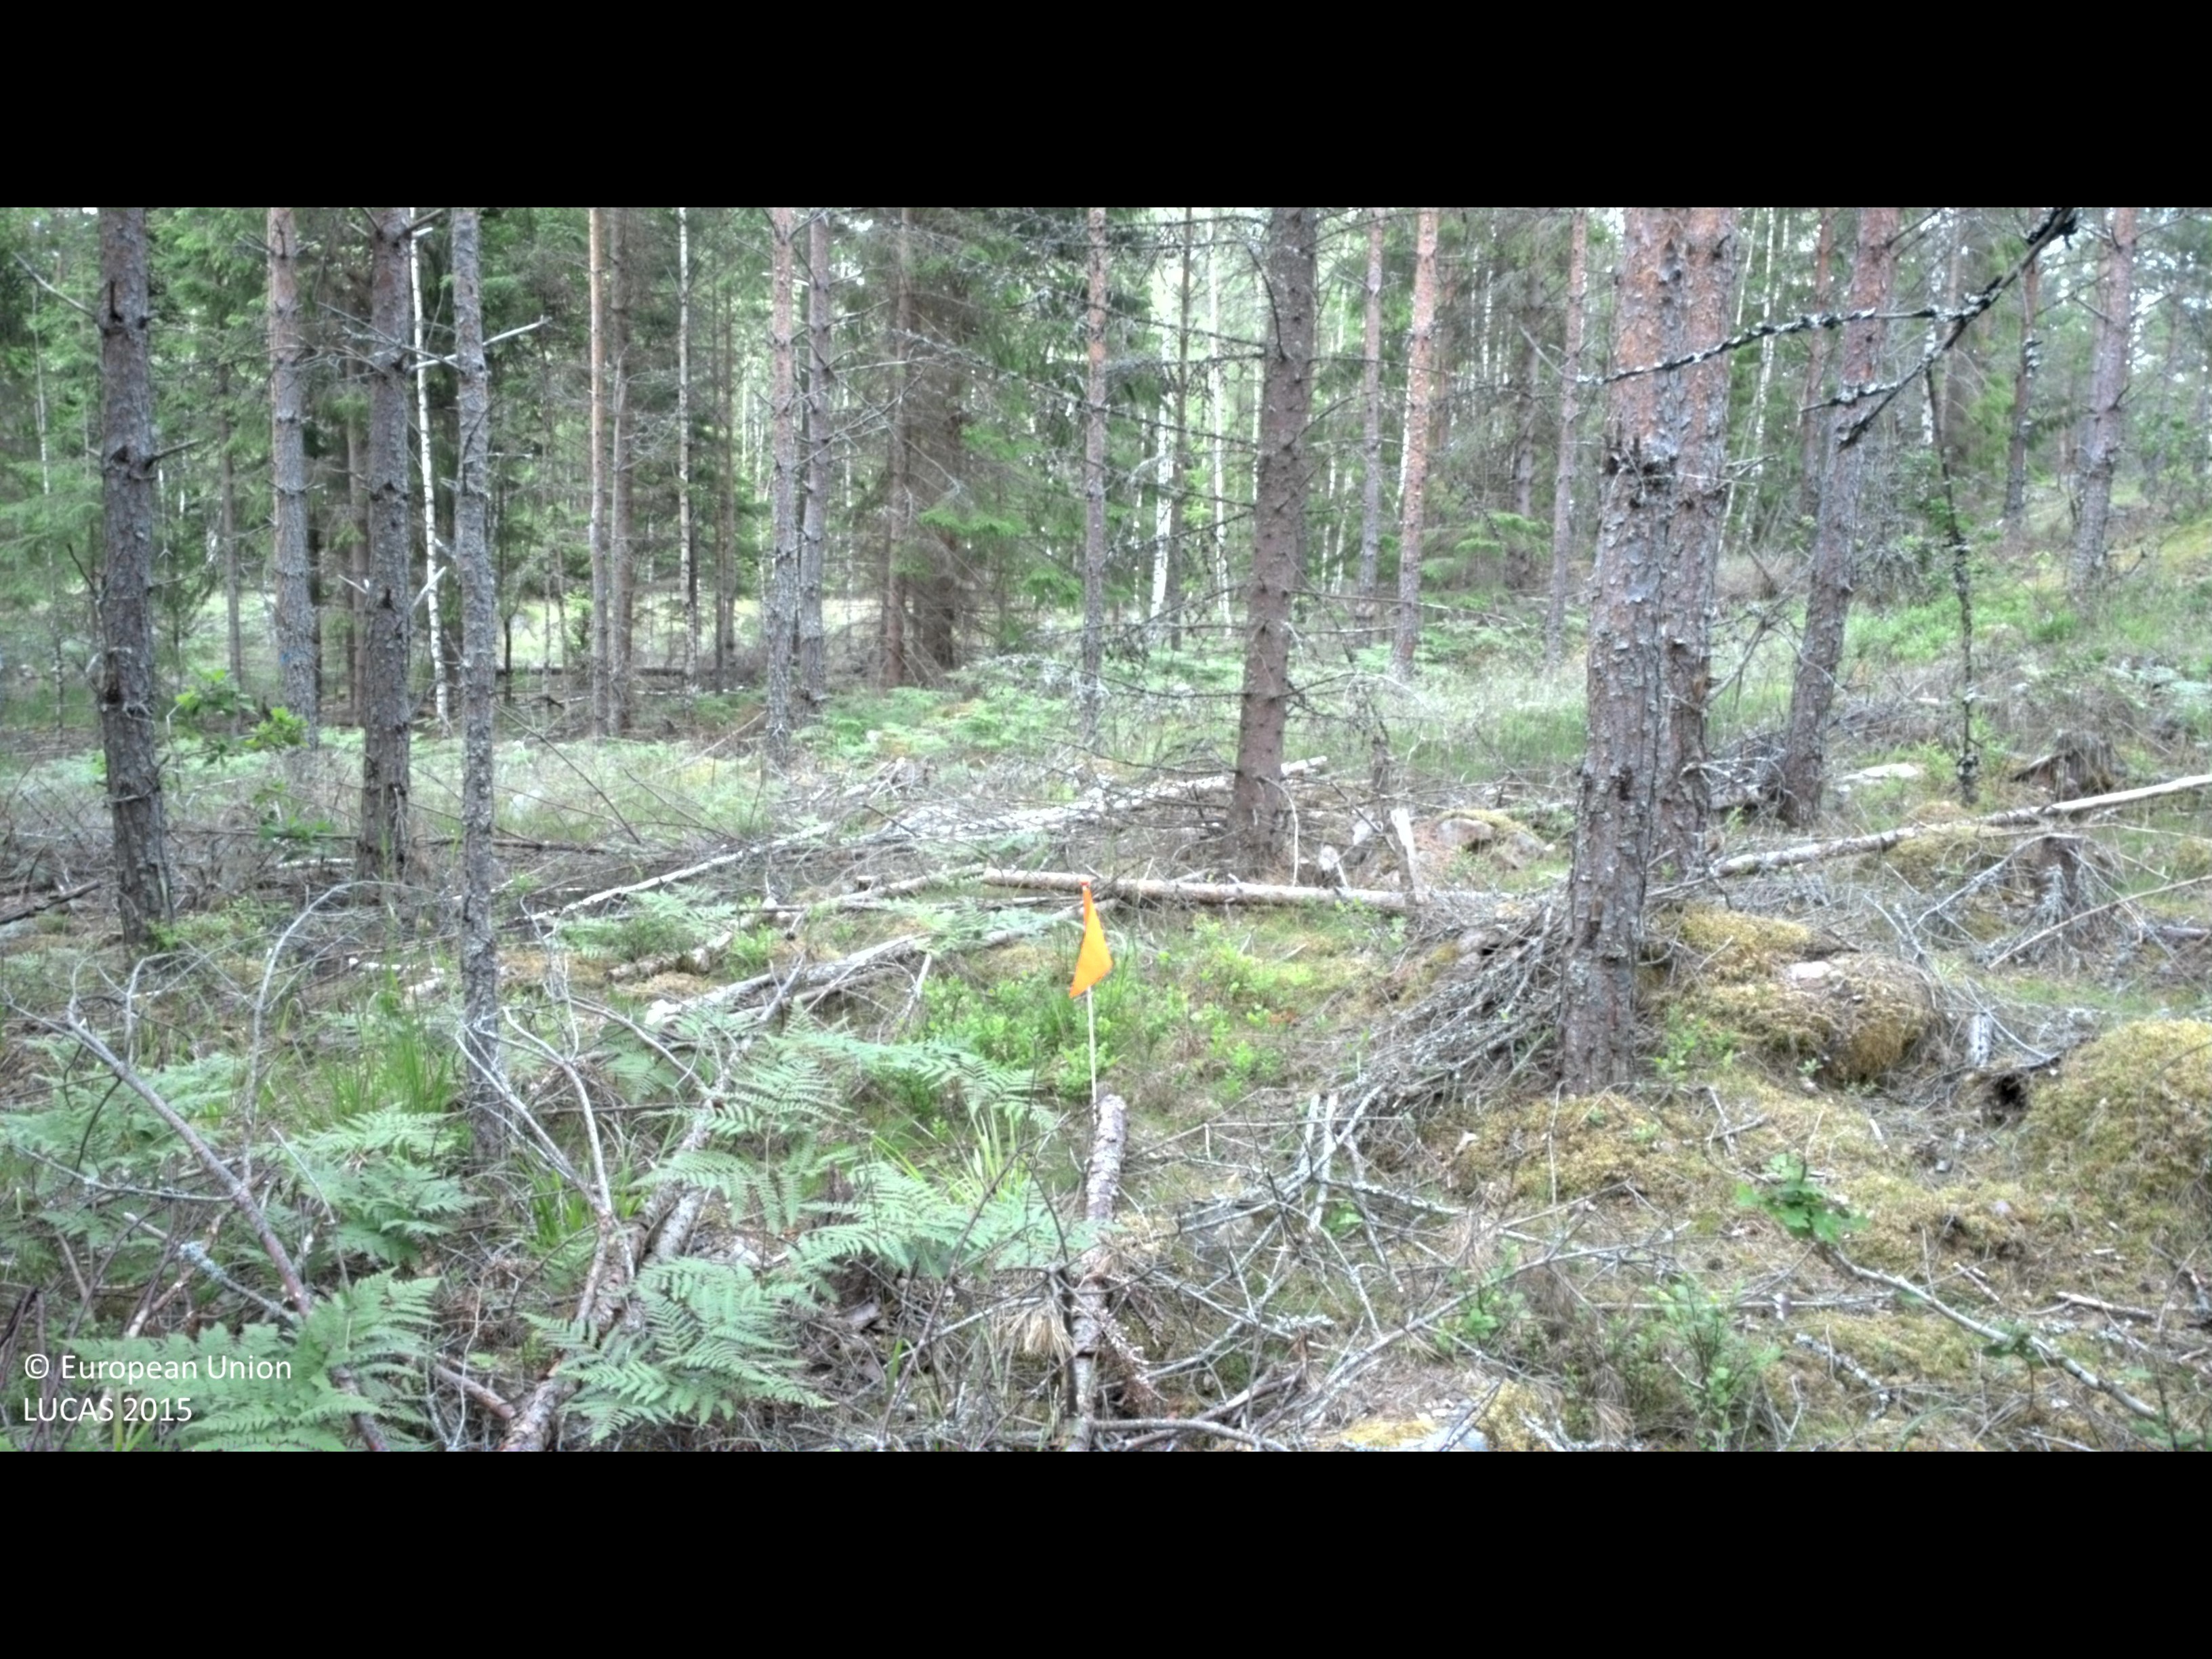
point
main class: Woodland
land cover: Pine dominated mixed woodland
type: boreal forest
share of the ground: 50 - 75 %
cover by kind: coniferous forest trees 45 %, broadleaved forest trees 20 %, herbaceous plants 15 %, shrubs 10 %, lichens and mosses 10 %
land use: Forestry
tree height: > 5 m
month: June
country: SE
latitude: 58.2562
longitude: 16.2162
